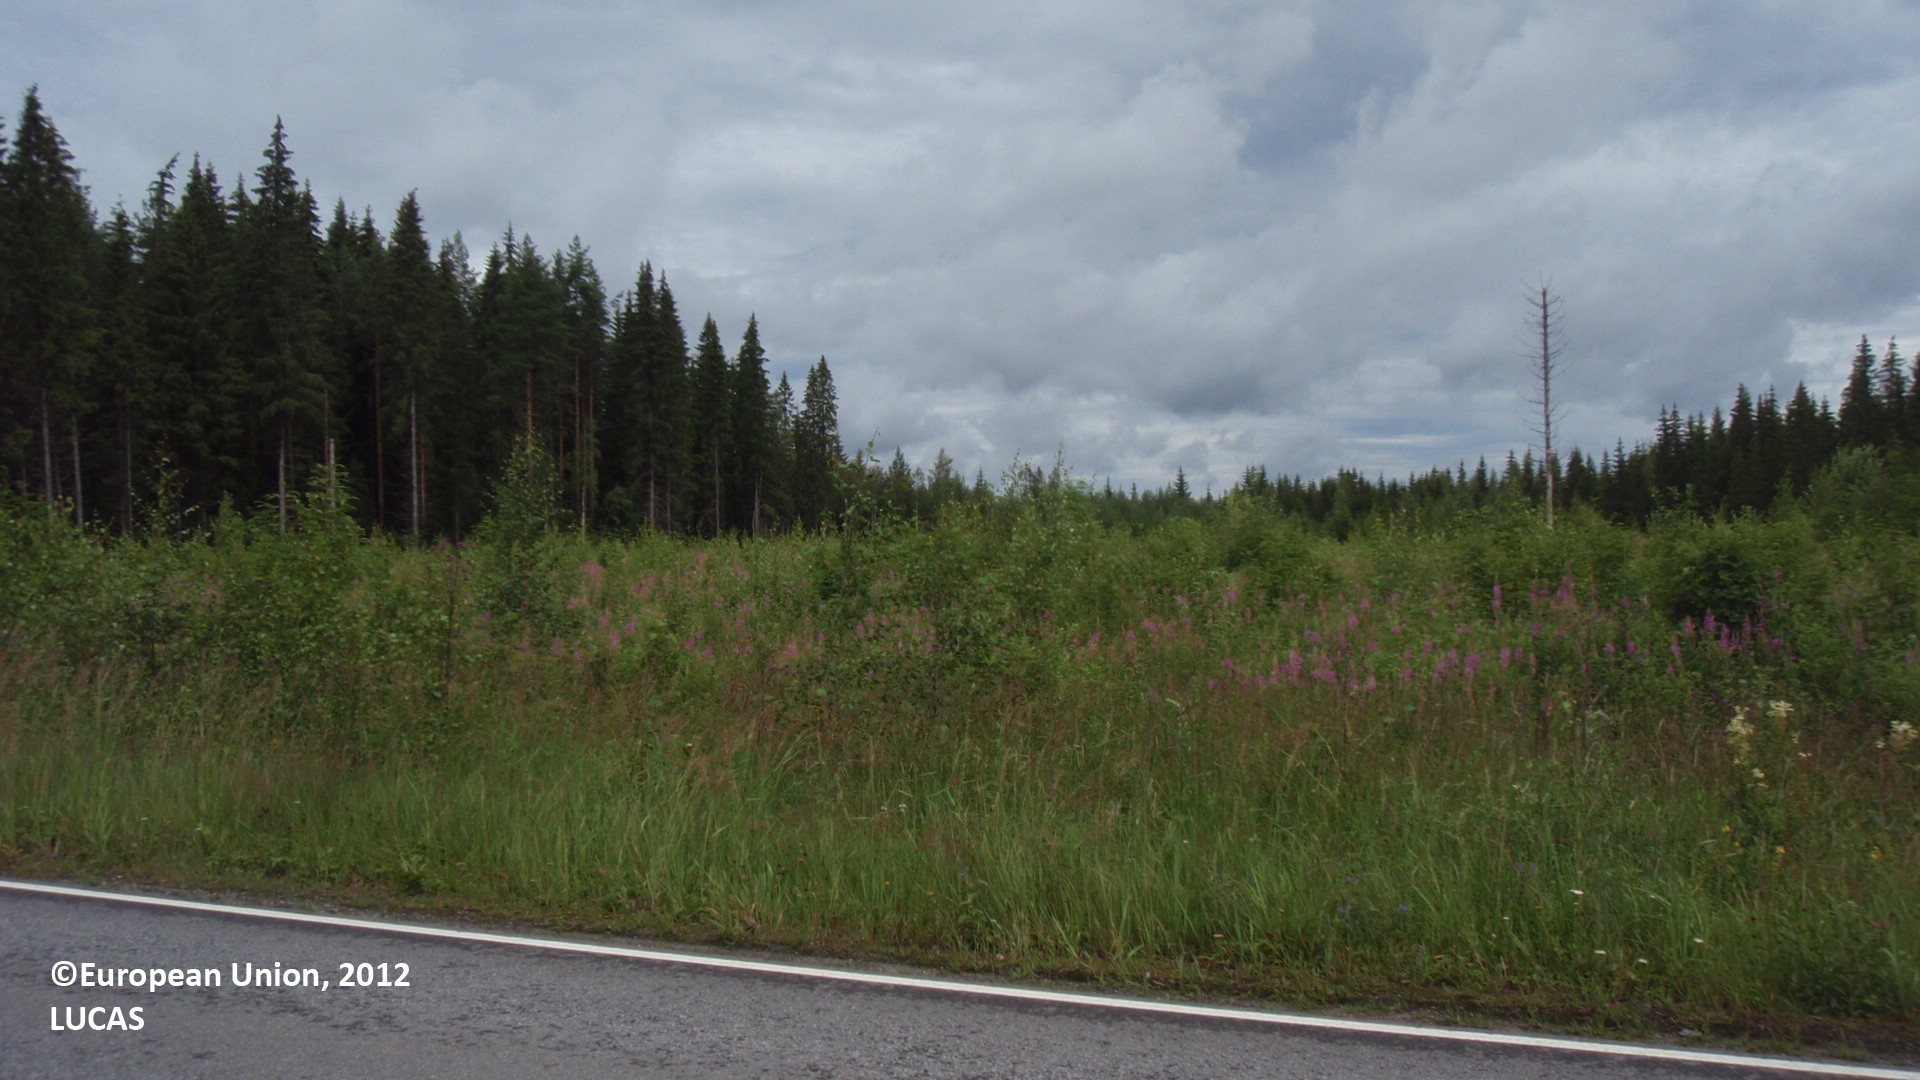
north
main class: Grassland
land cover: Grassland with sparse tree/shrub cover
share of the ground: > 75 %
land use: Road transport
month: July
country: FI
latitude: 61.5156
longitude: 27.2166
